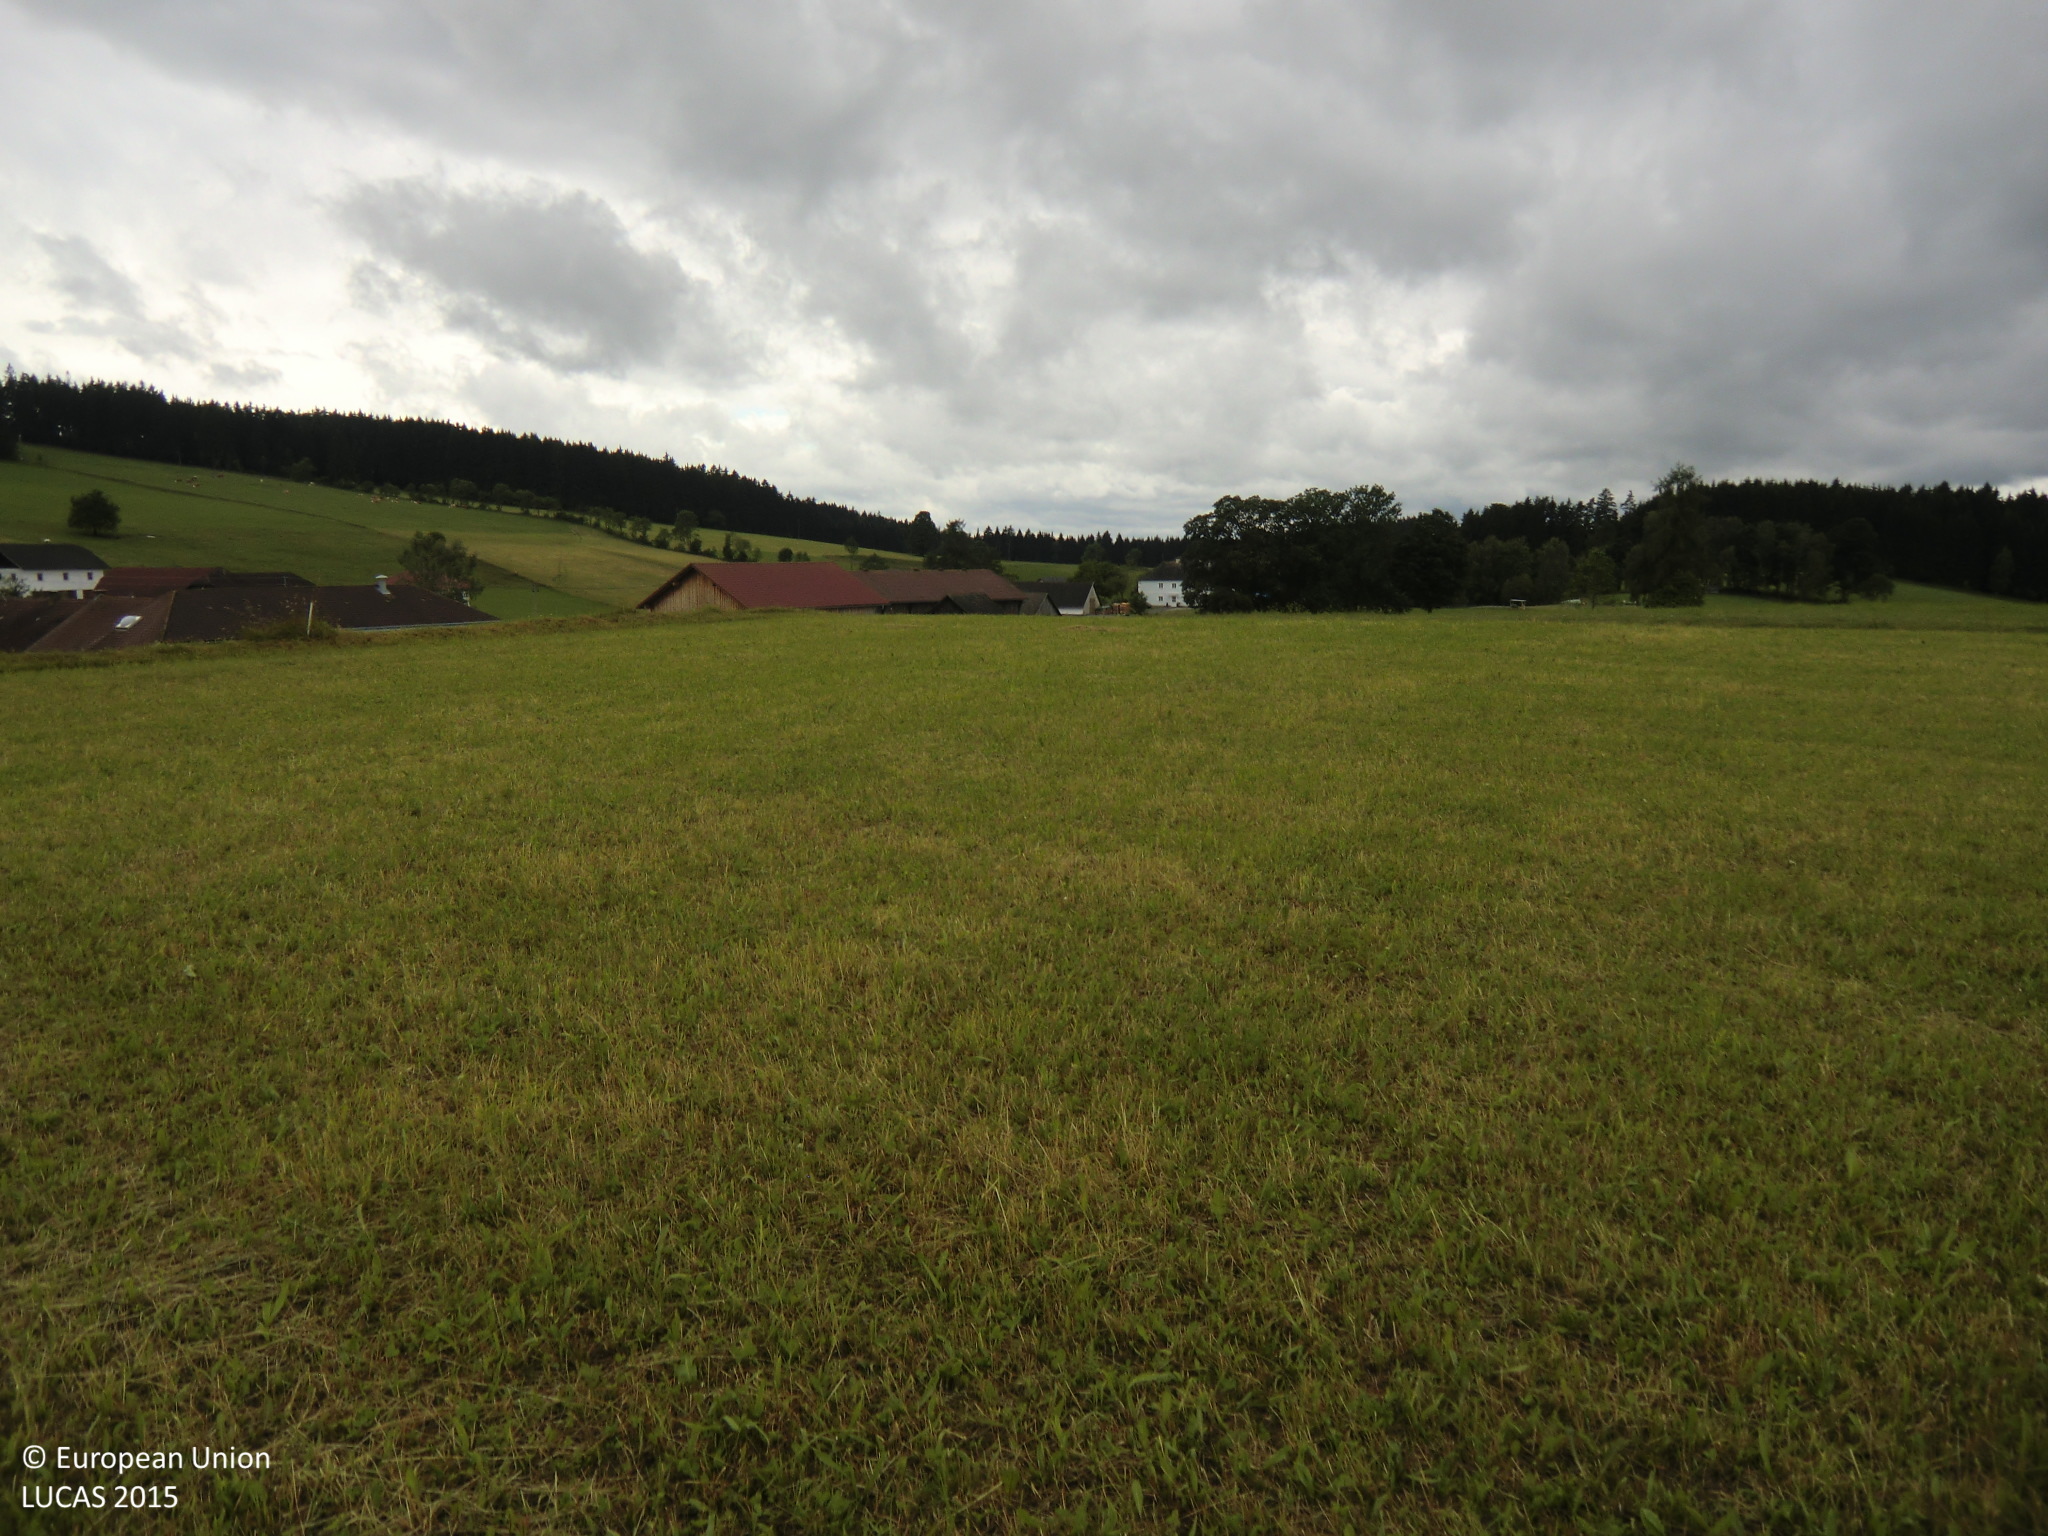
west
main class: Grassland
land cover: Grassland without tree/shrub cover
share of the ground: > 75 %
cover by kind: herbaceous plants 100 %
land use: Agriculture (excluding fallow land and kitchen gardens)
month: June
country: AT
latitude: 48.5435
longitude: 14.5656
